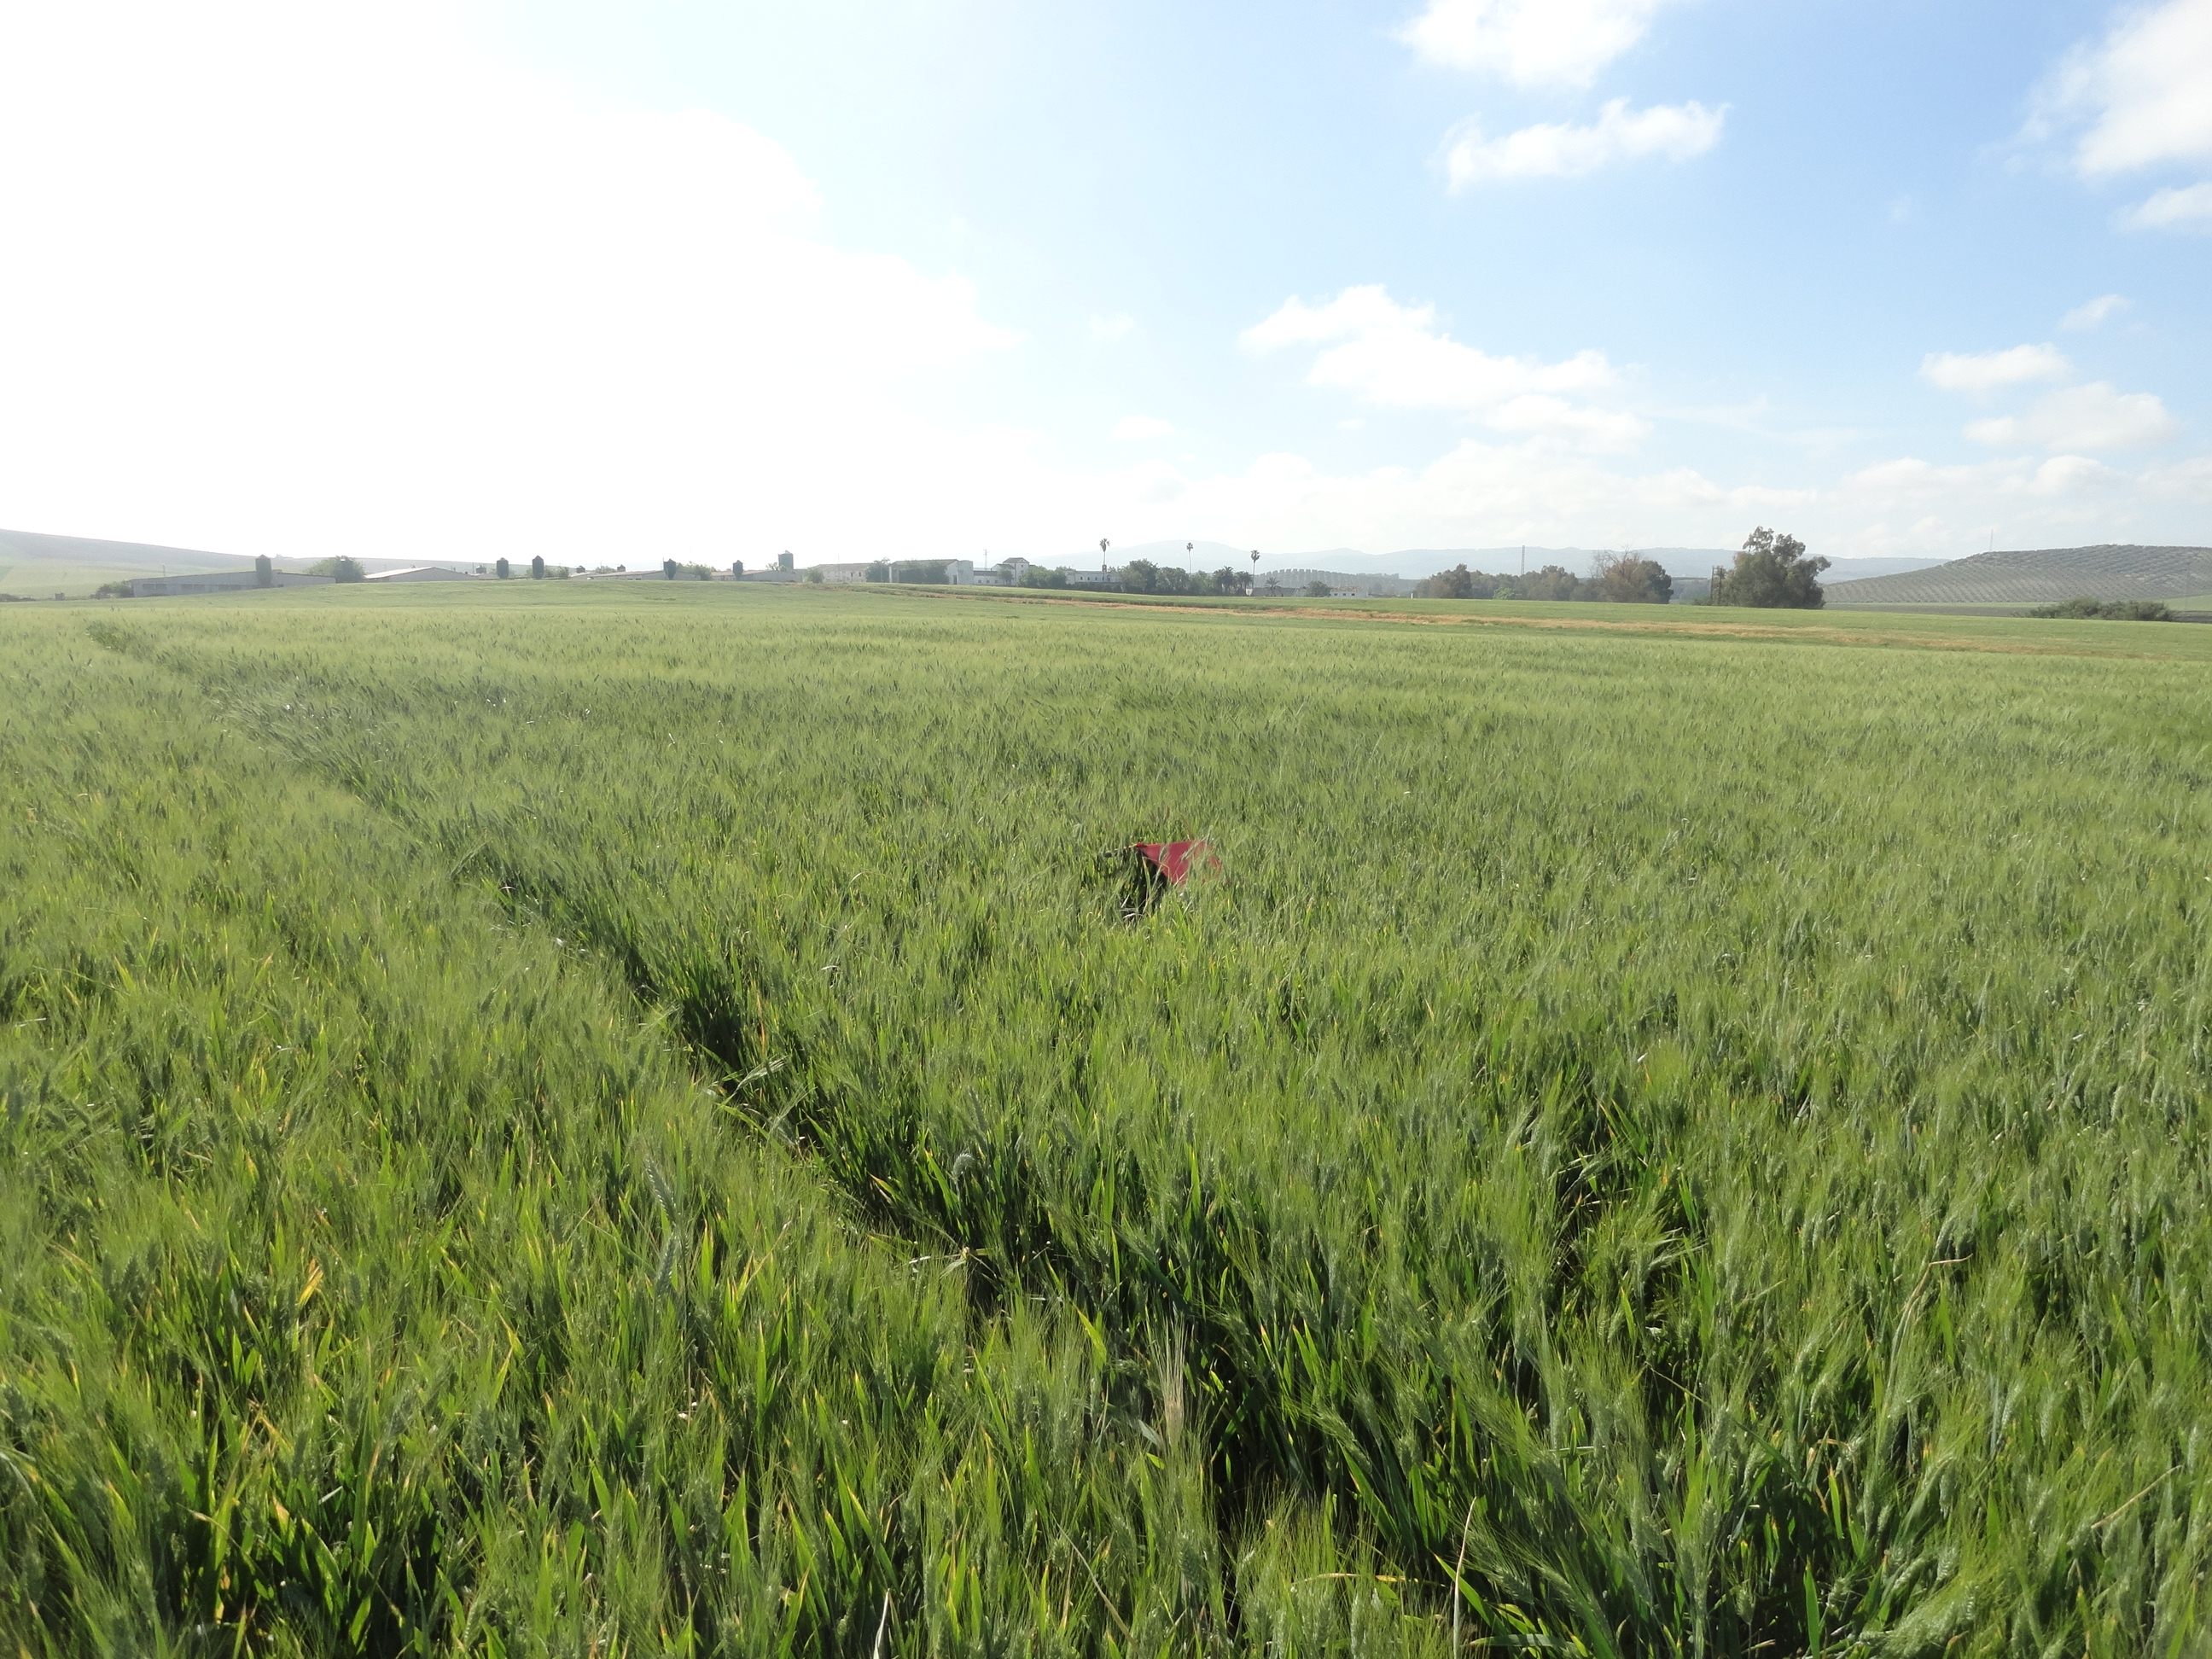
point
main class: Cropland
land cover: Durum wheat
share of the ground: > 75 %
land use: Agriculture (excluding fallow land and kitchen gardens)
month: April
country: ES
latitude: 37.6592
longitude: -4.6202
